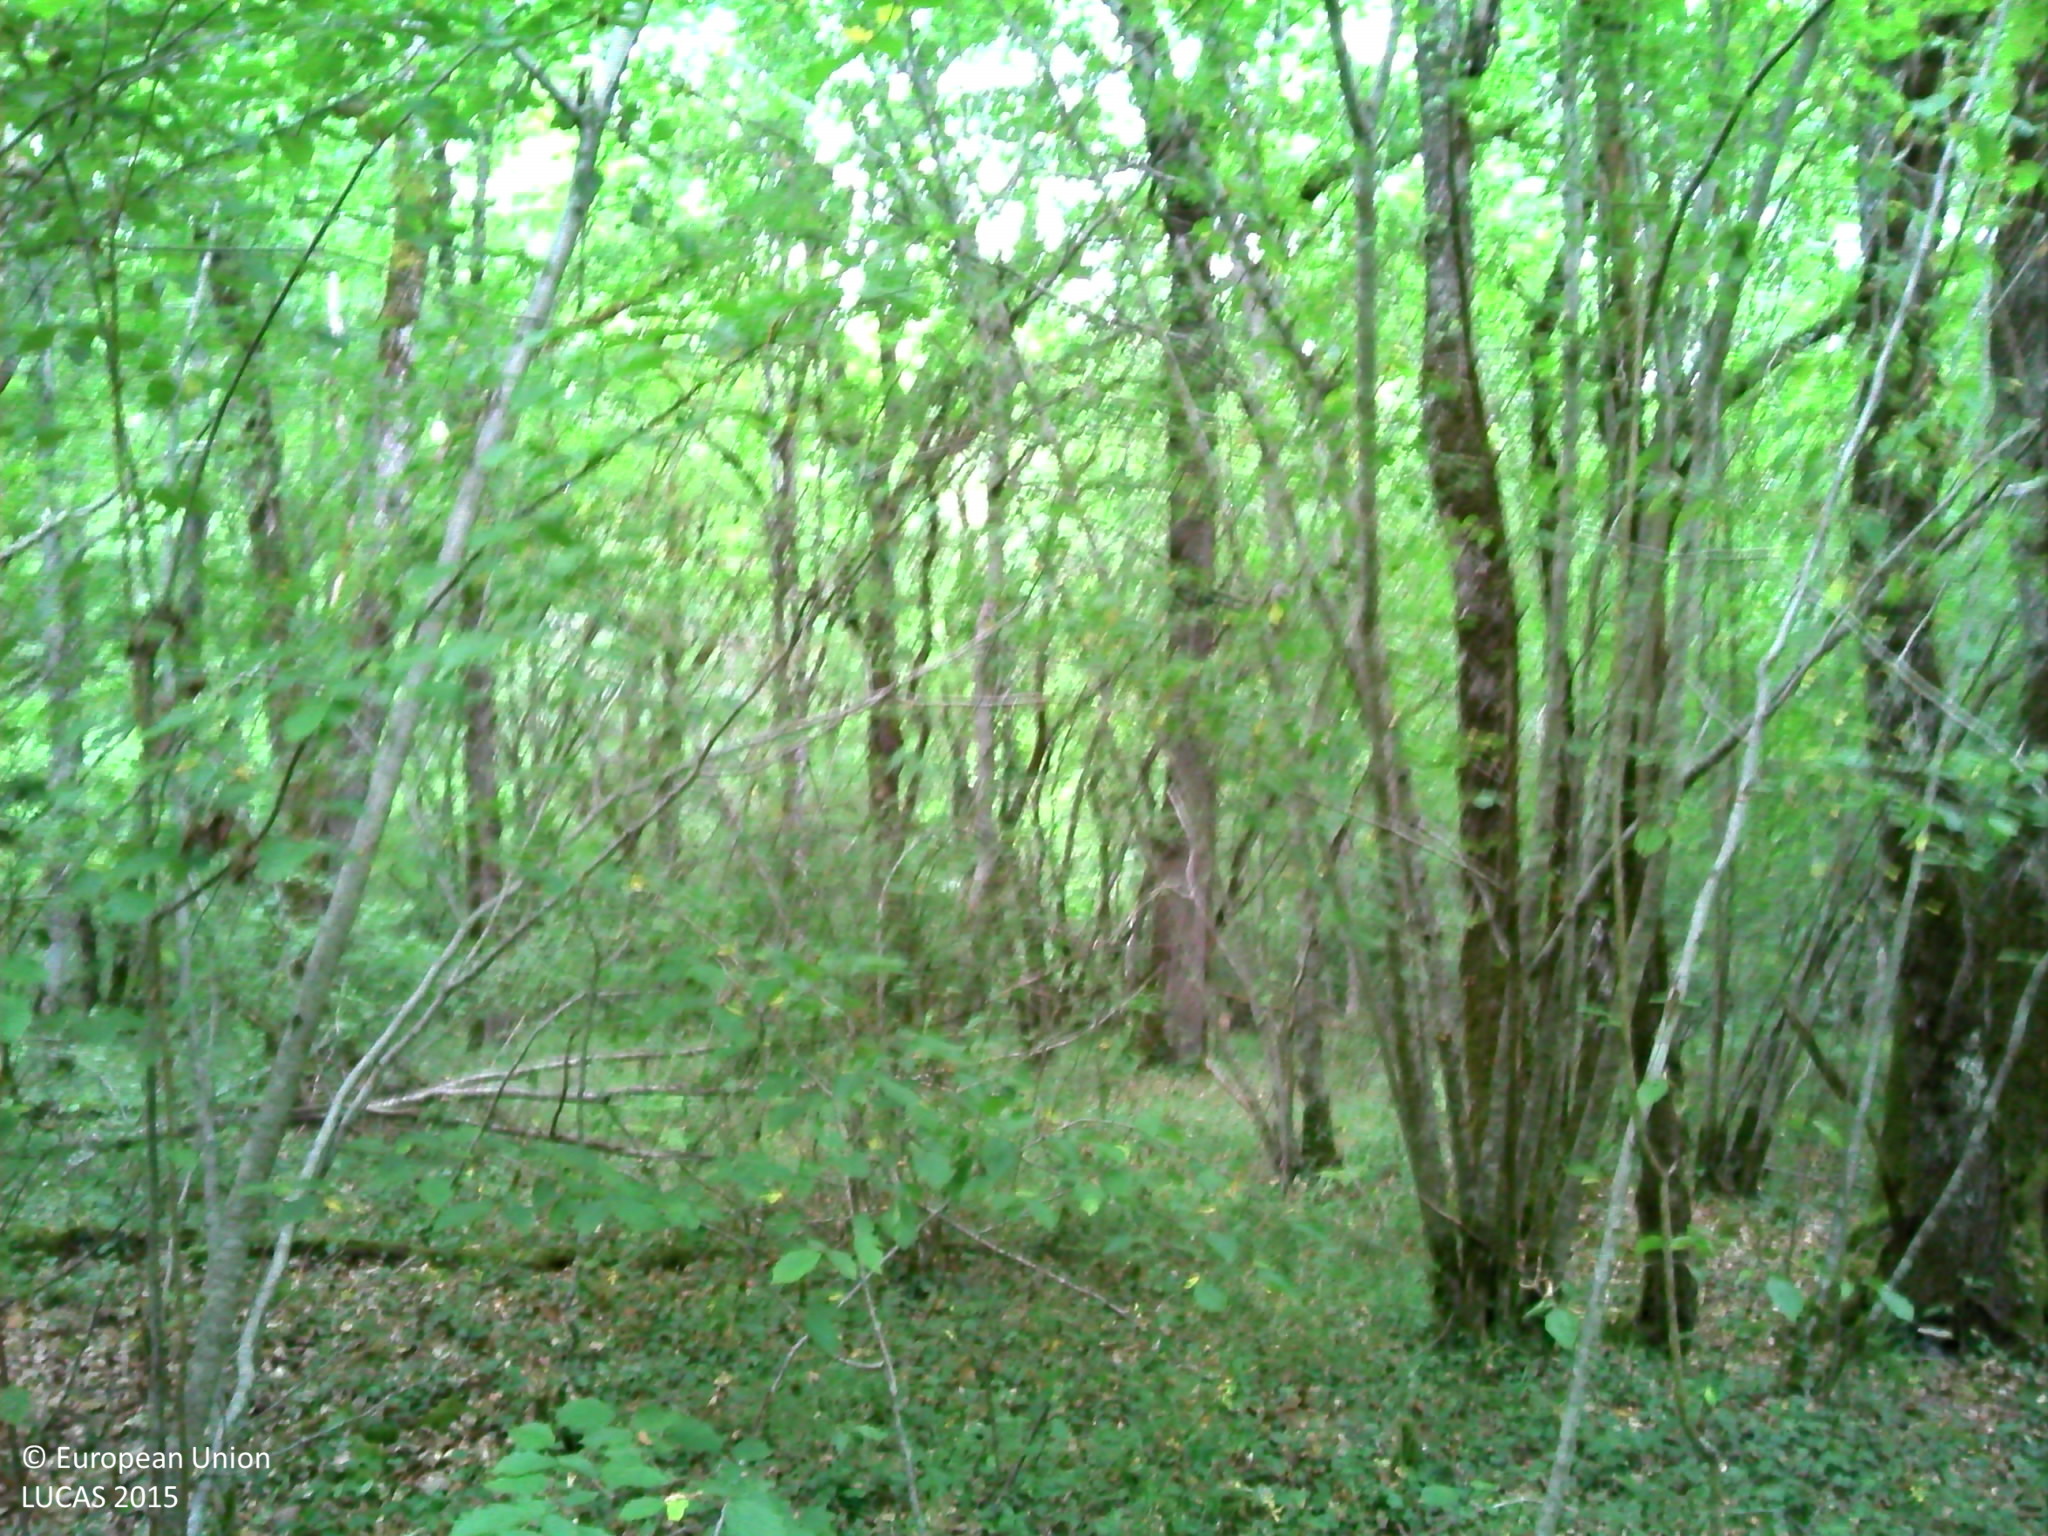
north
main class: Woodland
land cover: Broadleaved woodland
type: acidophilous oak and oak-birch forest
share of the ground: > 75 %
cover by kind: broadleaved forest trees 70 %, herbaceous plants 20 %, shrubs 5 %, lichens and mosses 5 %
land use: Forestry
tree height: > 5 m
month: July
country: FR
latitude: 44.8632
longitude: 0.7660
